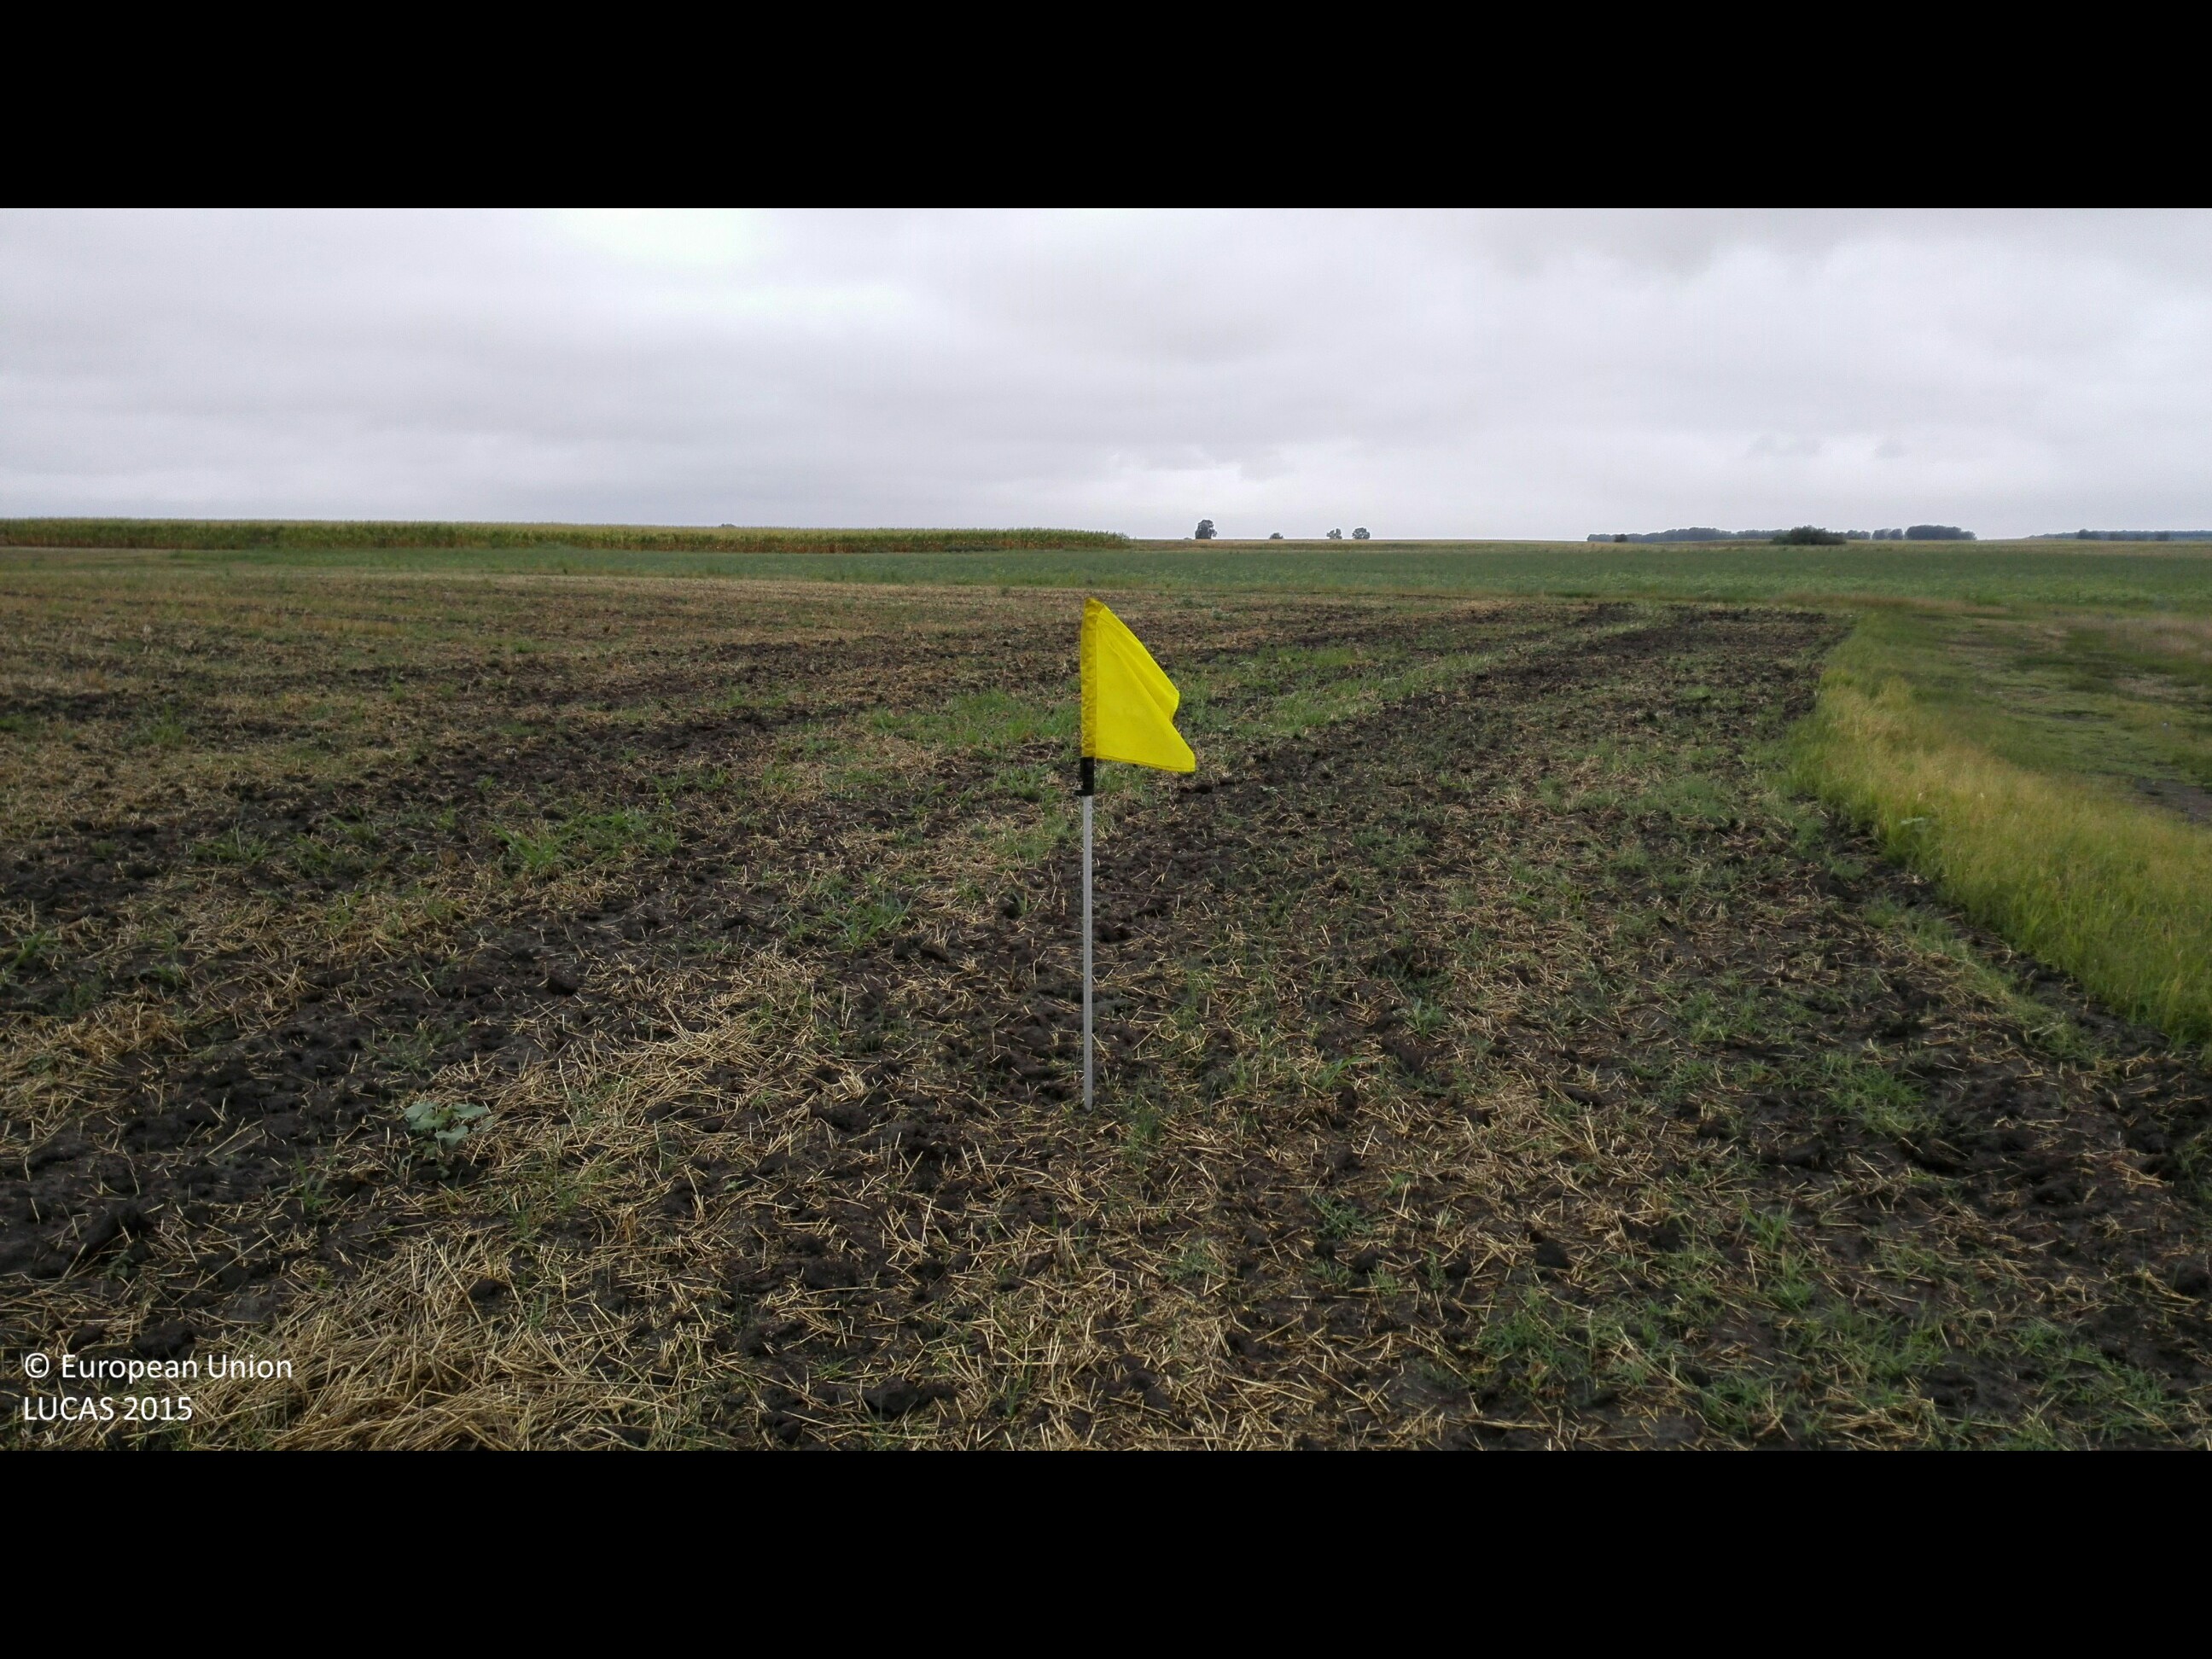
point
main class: Cropland
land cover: Common wheat
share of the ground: 10 - 25 %
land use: Agriculture (excluding fallow land and kitchen gardens)
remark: Harvested field
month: August
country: HU
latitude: 47.3075
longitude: 21.6975
